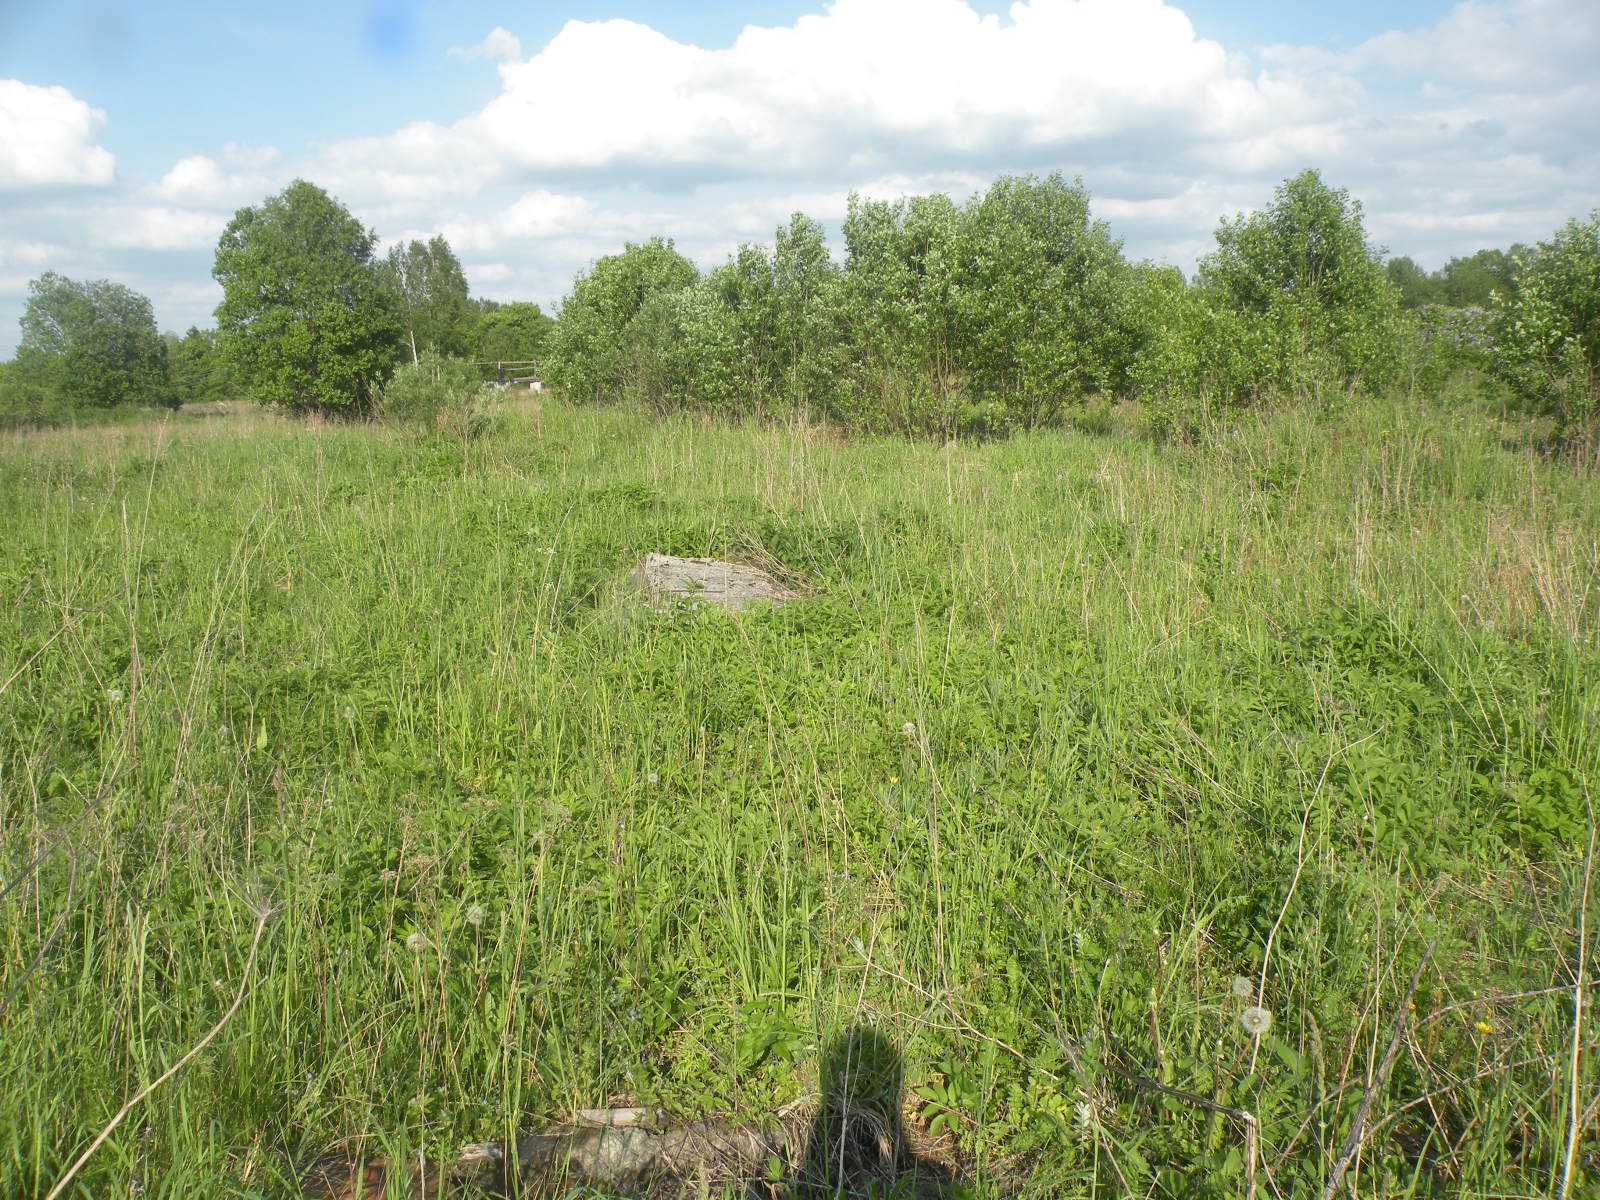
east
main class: Grassland
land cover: Spontaneously vegetated surfaces
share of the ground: > 75 %
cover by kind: herbaceous plants 95 %, shrubs 5 %
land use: Abandoned areas
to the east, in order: Spontaneously vegetated surfaces; Broadleaved woodland; Spontaneously vegetated surfaces; Tracks; Spontaneously vegetated surfaces; Artificial constructions in urban areas; Grassland without tree/shrub cover; Tracks; Broadleaved woodland; Spontaneously vegetated surfaces; Broadleaved woodland; Inland fresh running water
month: May
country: LV
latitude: 55.9252
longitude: 26.1605
